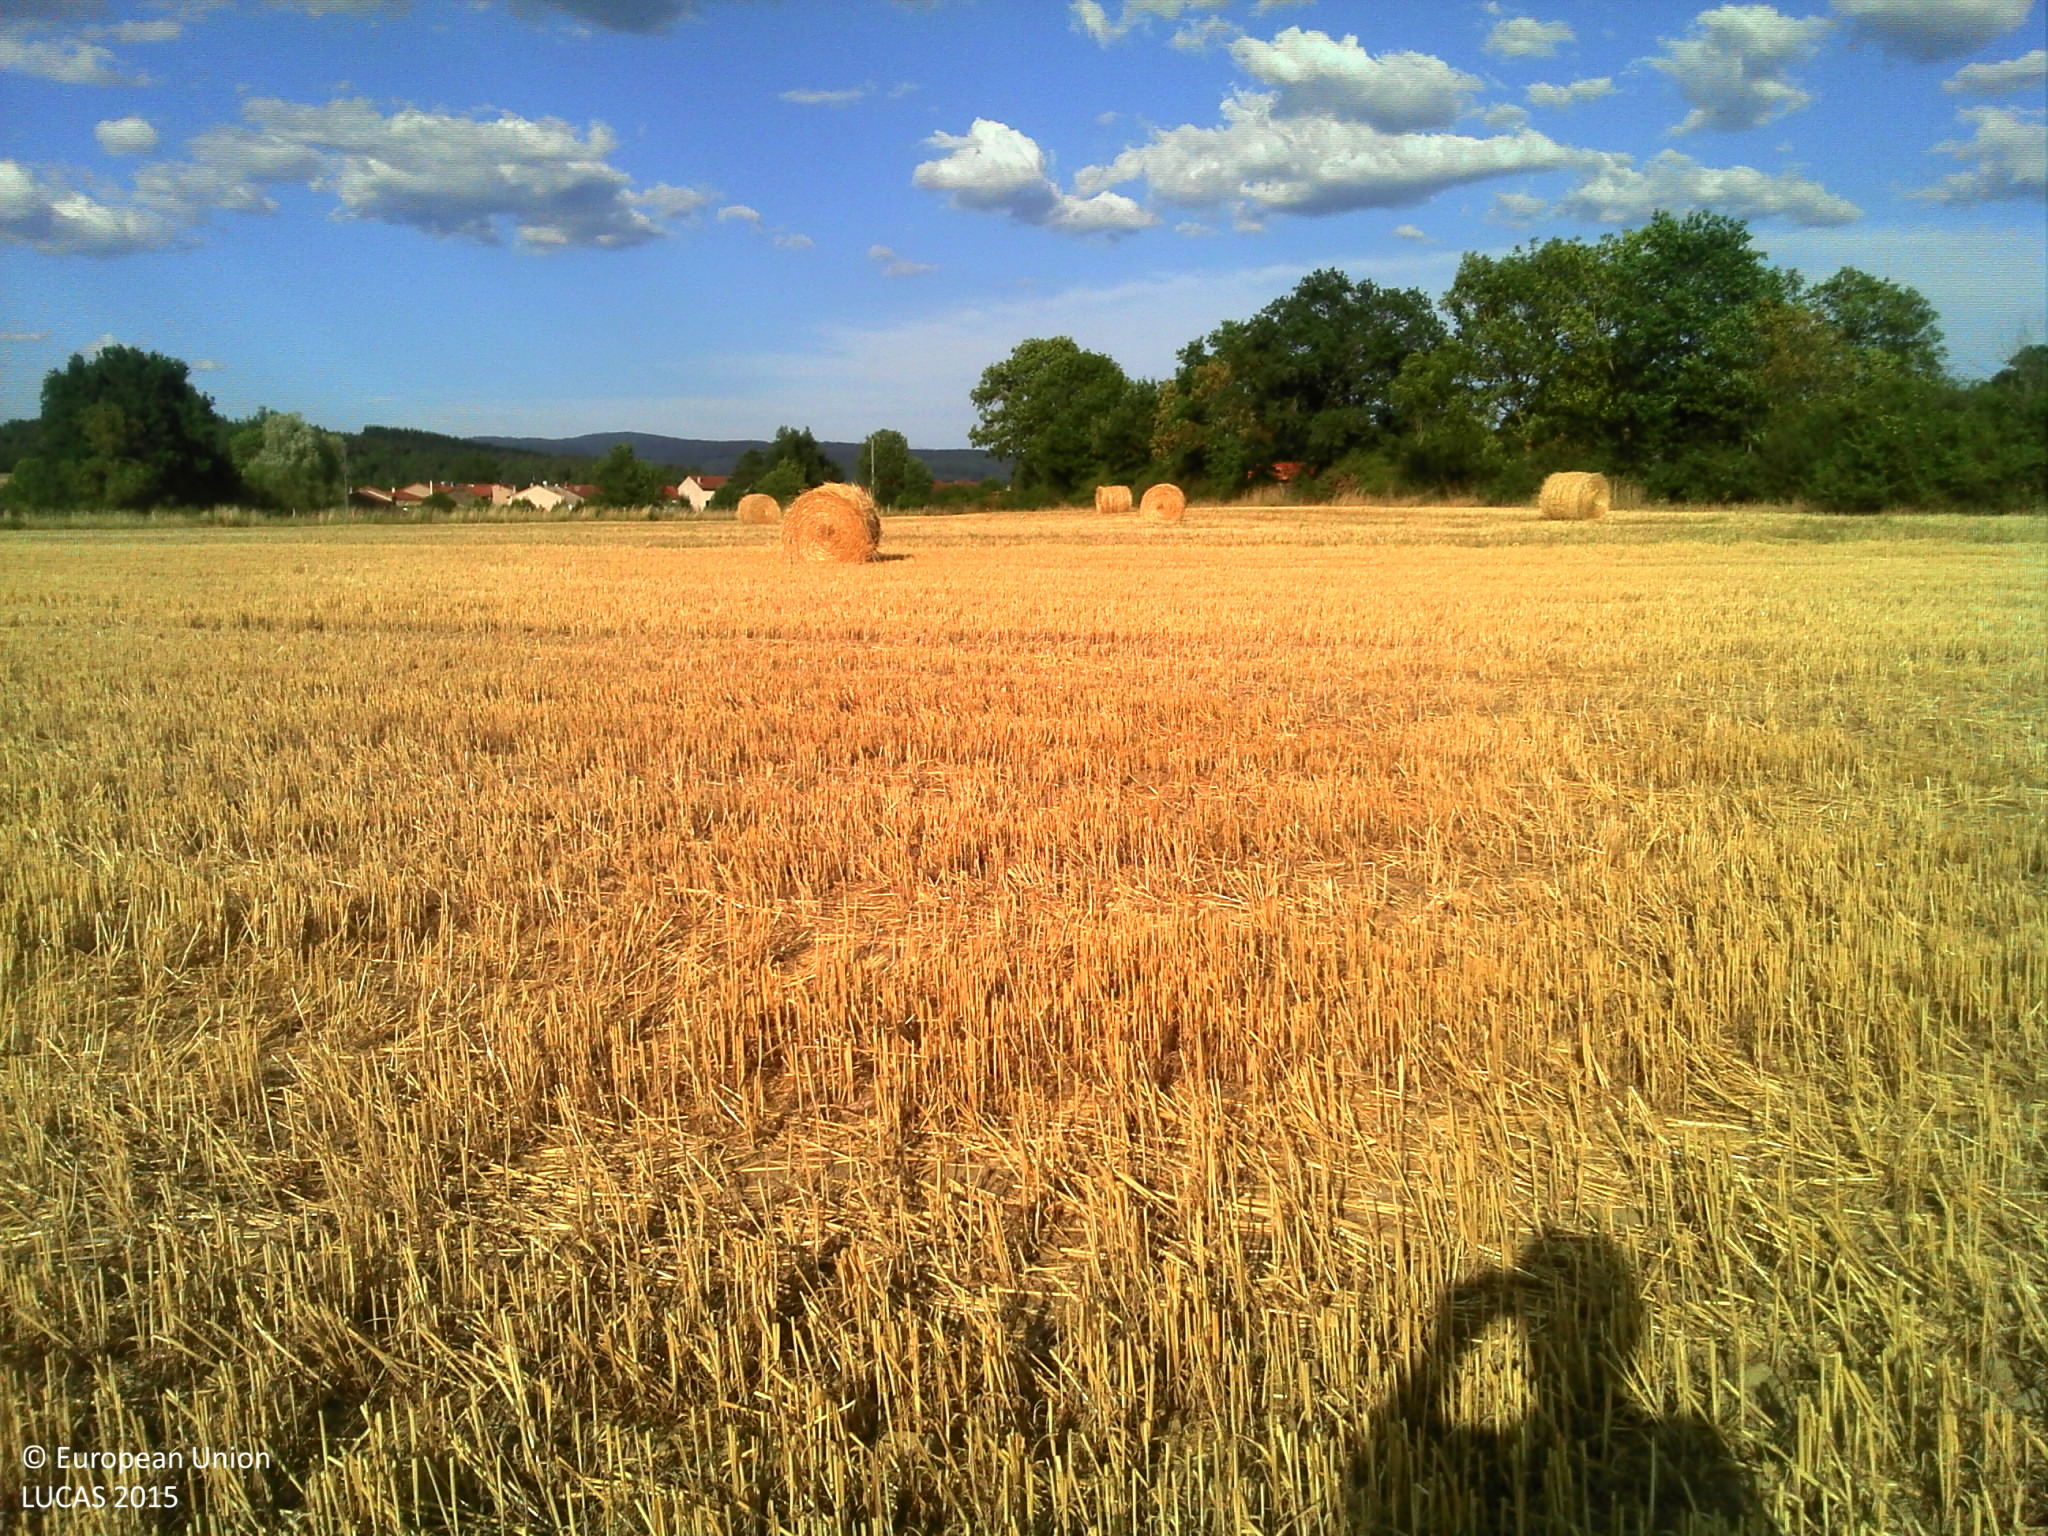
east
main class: Cropland
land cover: Durum wheat
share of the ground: > 75 %
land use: Agriculture (excluding fallow land and kitchen gardens)
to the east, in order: Durum wheat; Grass margins; Abandoned hedges; Fences; Grassland without tree/shrub cover; Artificial constructions in urban areas; Grassland without tree/shrub cover; Managed hedges; Electric lines; Ditches and canals; Paved roads, cycling and walking lanes; Grass margins; Fences; Abandoned hedges; Grassland without tree/shrub cover
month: July
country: FR
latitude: 45.2298
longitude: 3.4686
